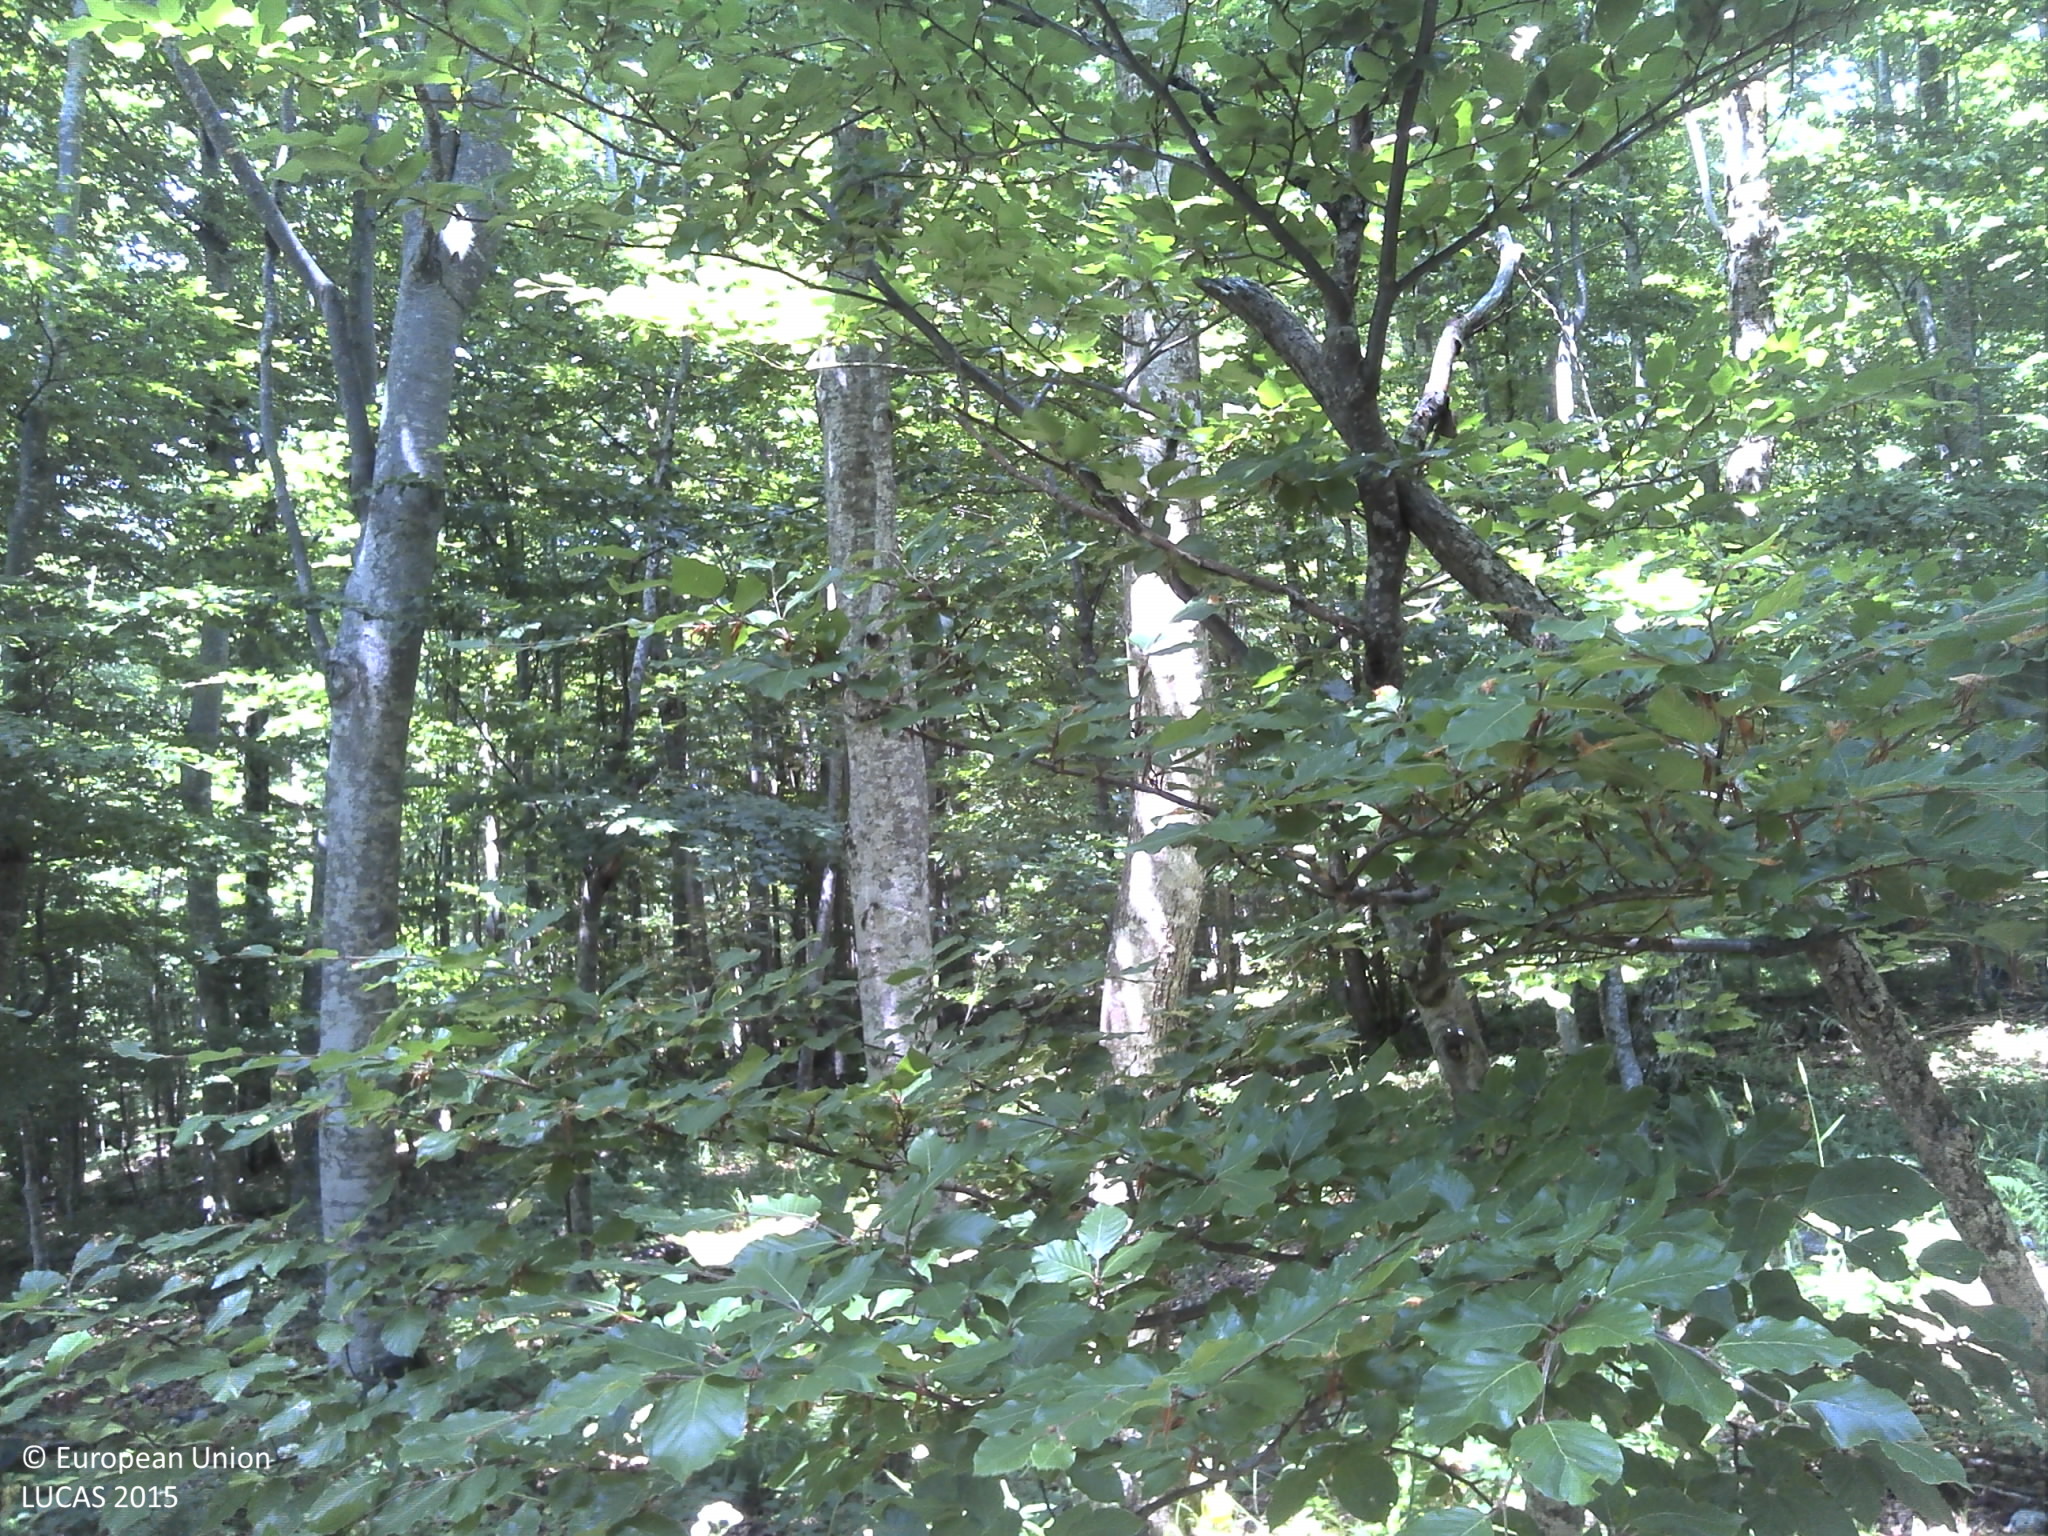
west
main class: Woodland
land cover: Broadleaved woodland
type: mountainous beech forest
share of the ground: > 75 %
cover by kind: broadleaved forest trees 95 %, consolidated bare surface 5 %
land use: Forestry
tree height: > 5 m
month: June
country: HR
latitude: 44.5042
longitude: 15.9683
